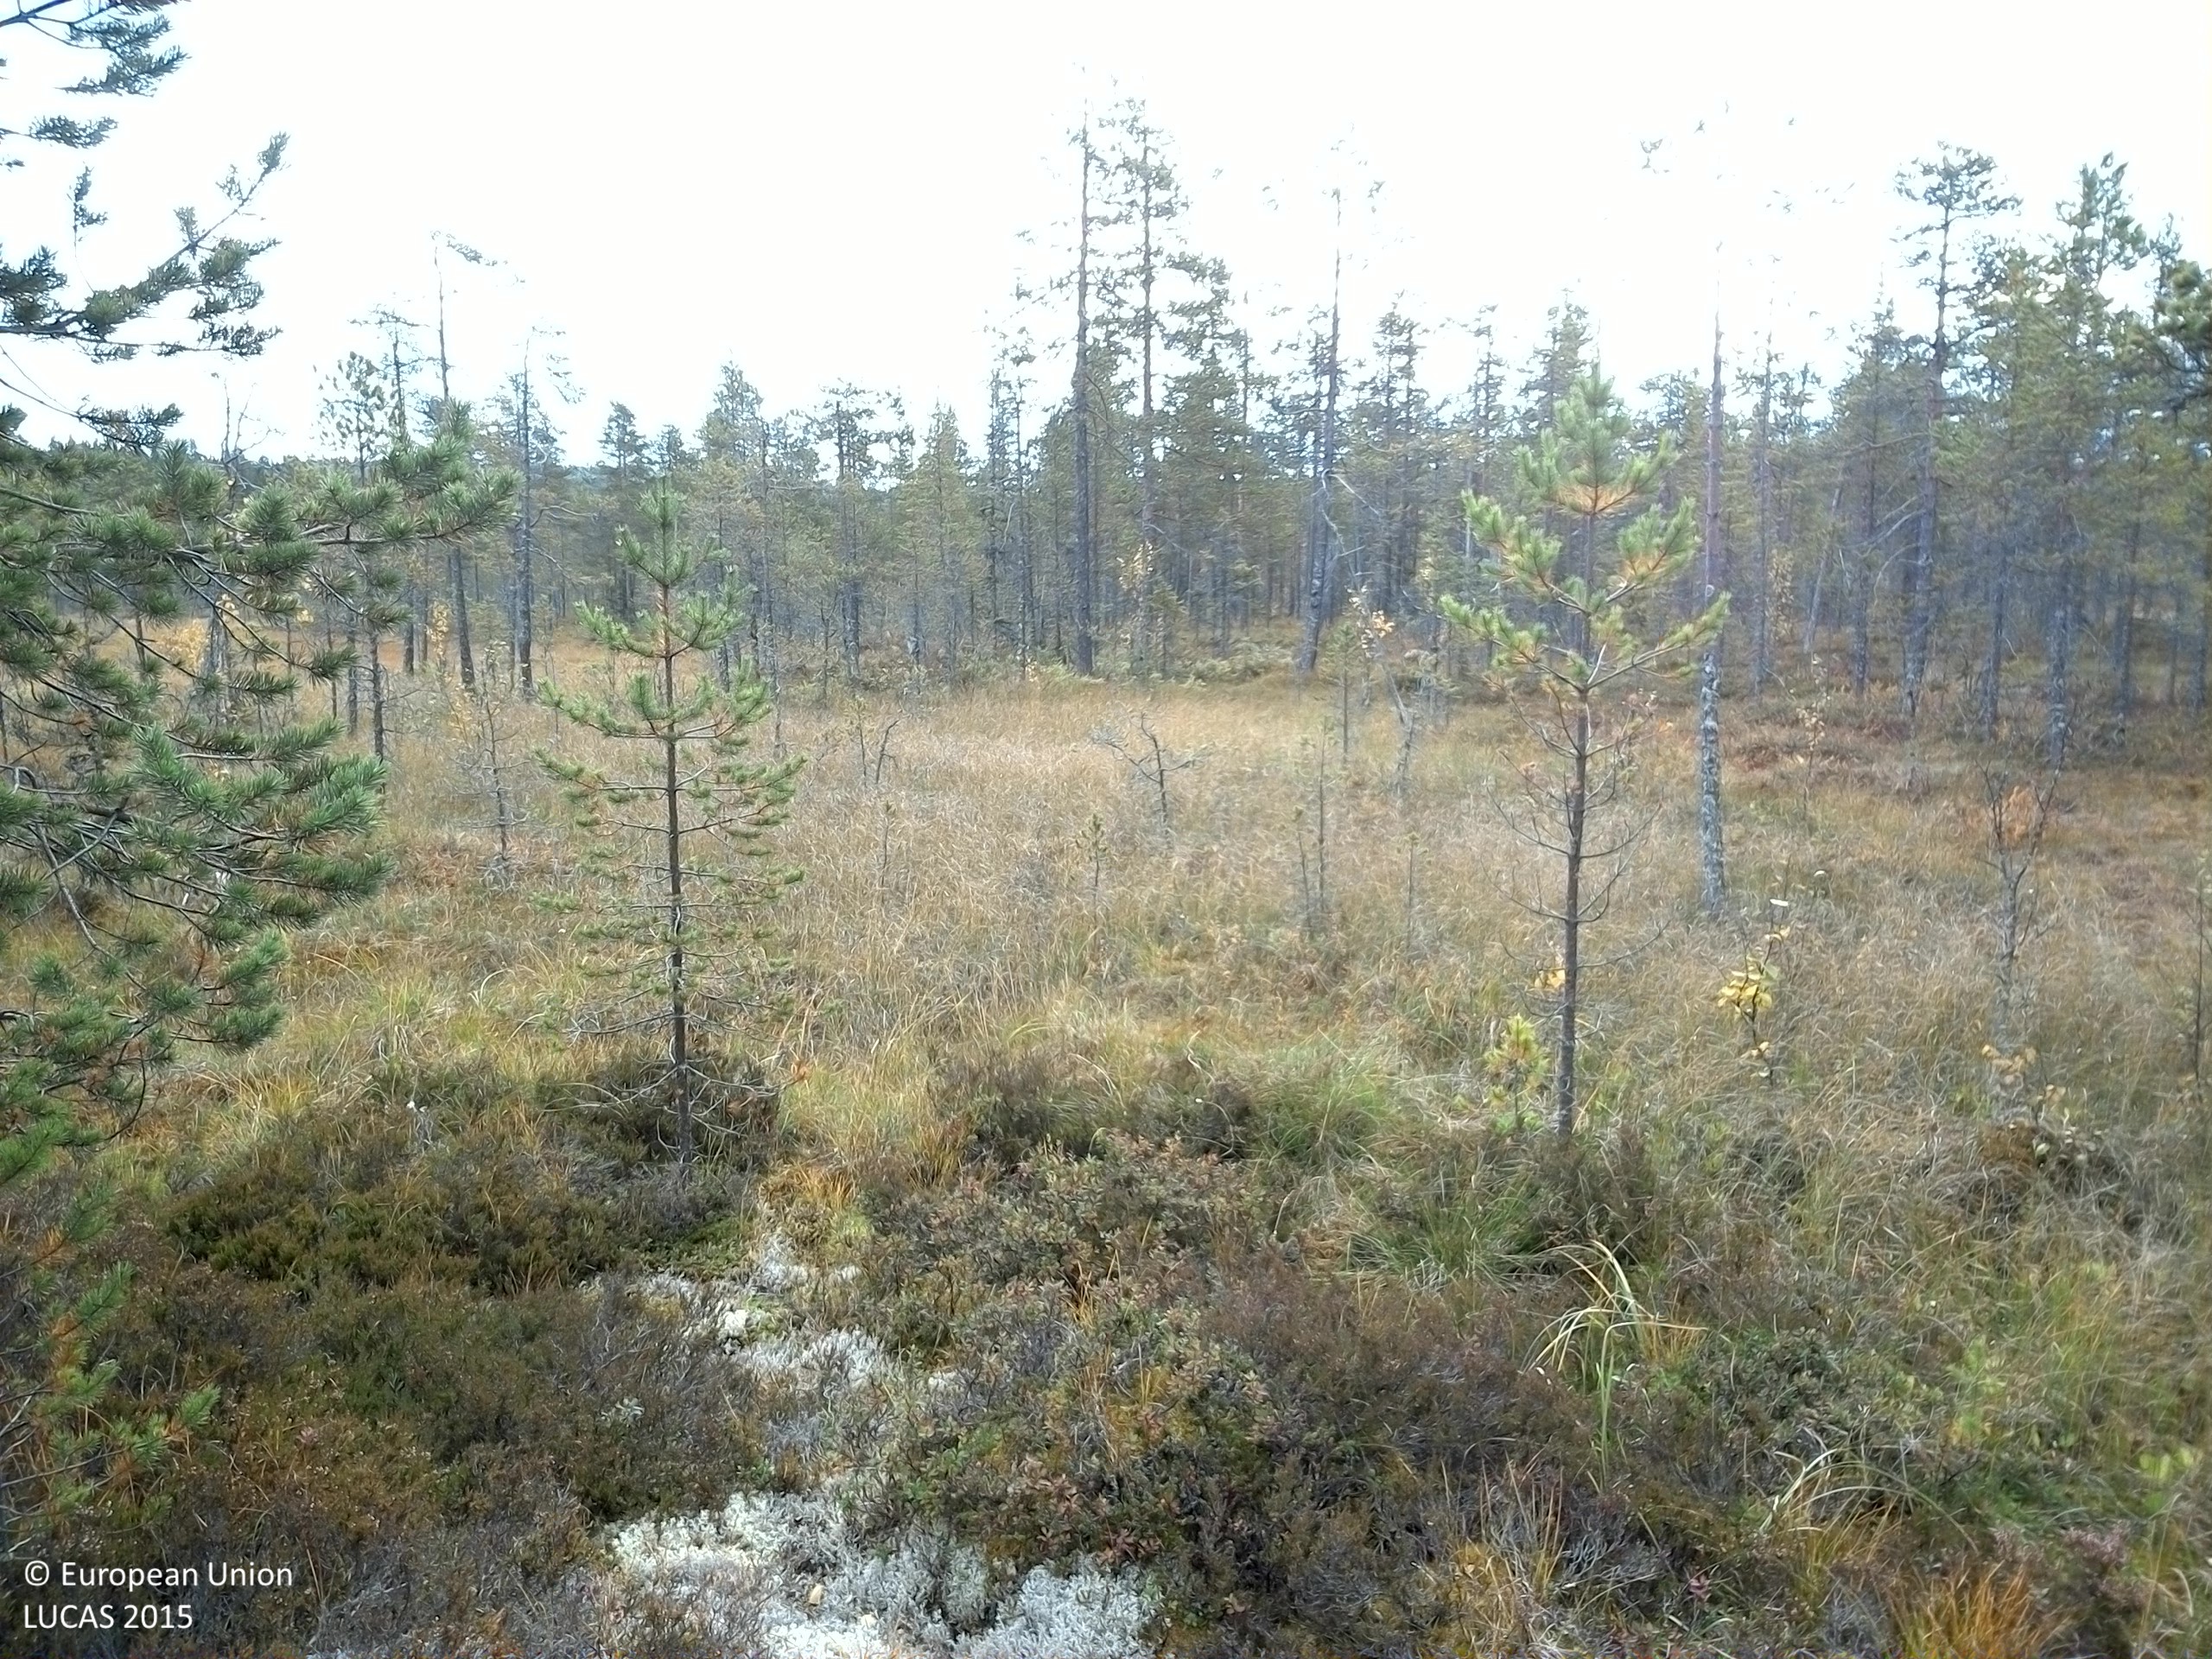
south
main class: Woodland
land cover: Pine dominated coniferous woodland
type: boreal forest
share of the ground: 10 - 25 %
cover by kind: lichens and mosses 35 %, shrubs 30 %, coniferous forest trees 15 %, herbaceous plants 15 %, broadleaved forest trees 5 %
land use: Forestry
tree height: < 5 m
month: September
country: SE
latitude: 61.5934
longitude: 14.9022
